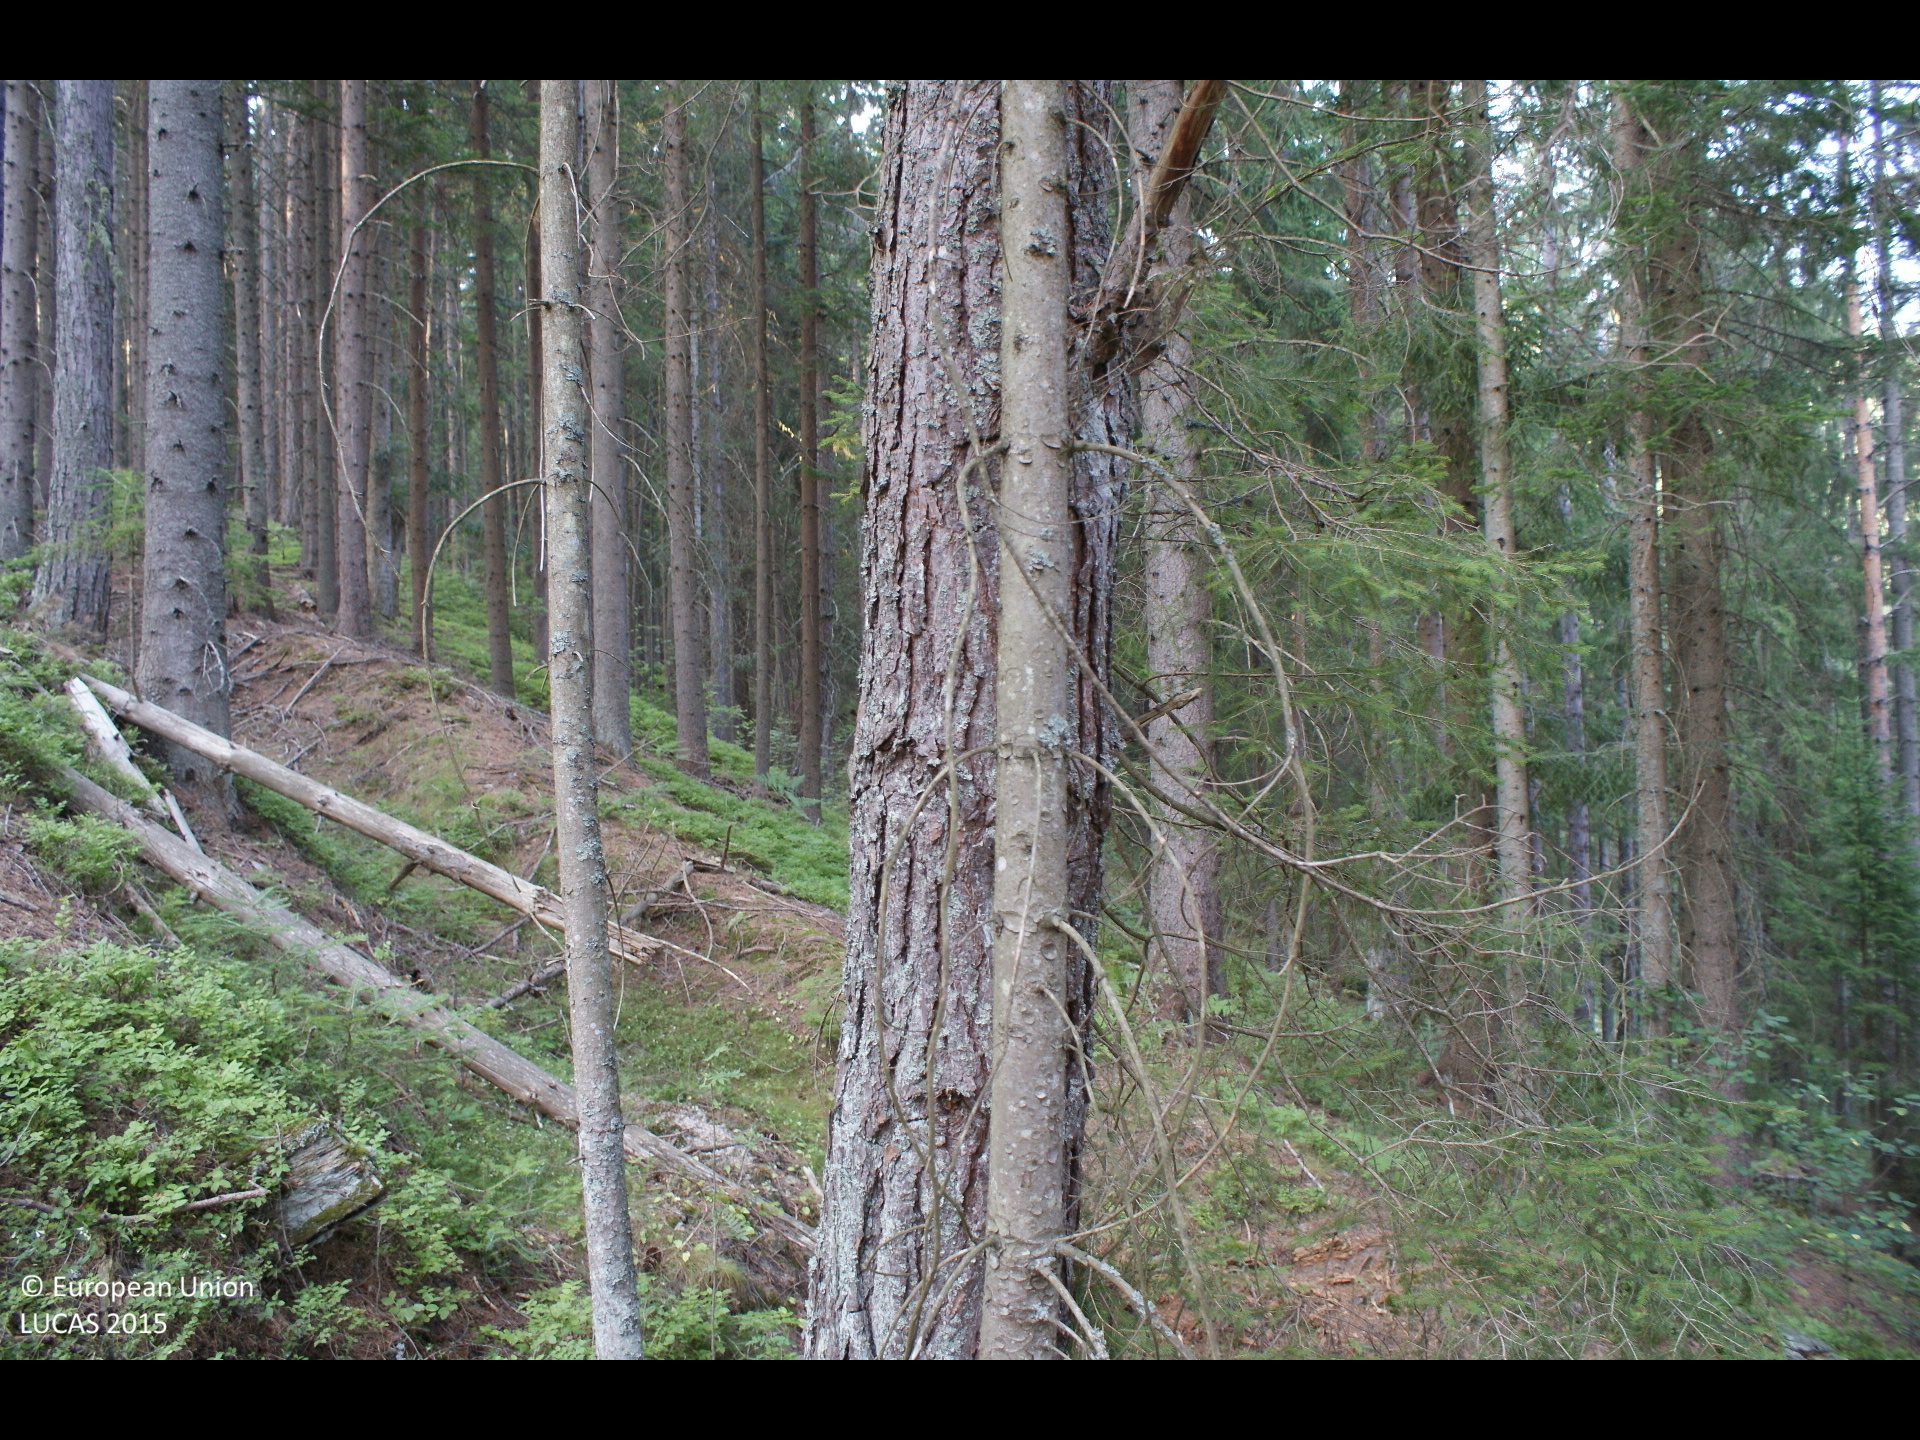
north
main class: Woodland
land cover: Spruce dominated coniferous woodland
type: alpine coniferous forest
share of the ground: > 75 %
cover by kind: coniferous forest trees 80 %, shrubs 10 %, herbaceous plants 5 %, unconsolidated bare surface 5 %
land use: Forestry
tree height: > 5 m
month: August
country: AT
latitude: 47.4972
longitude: 15.3768
